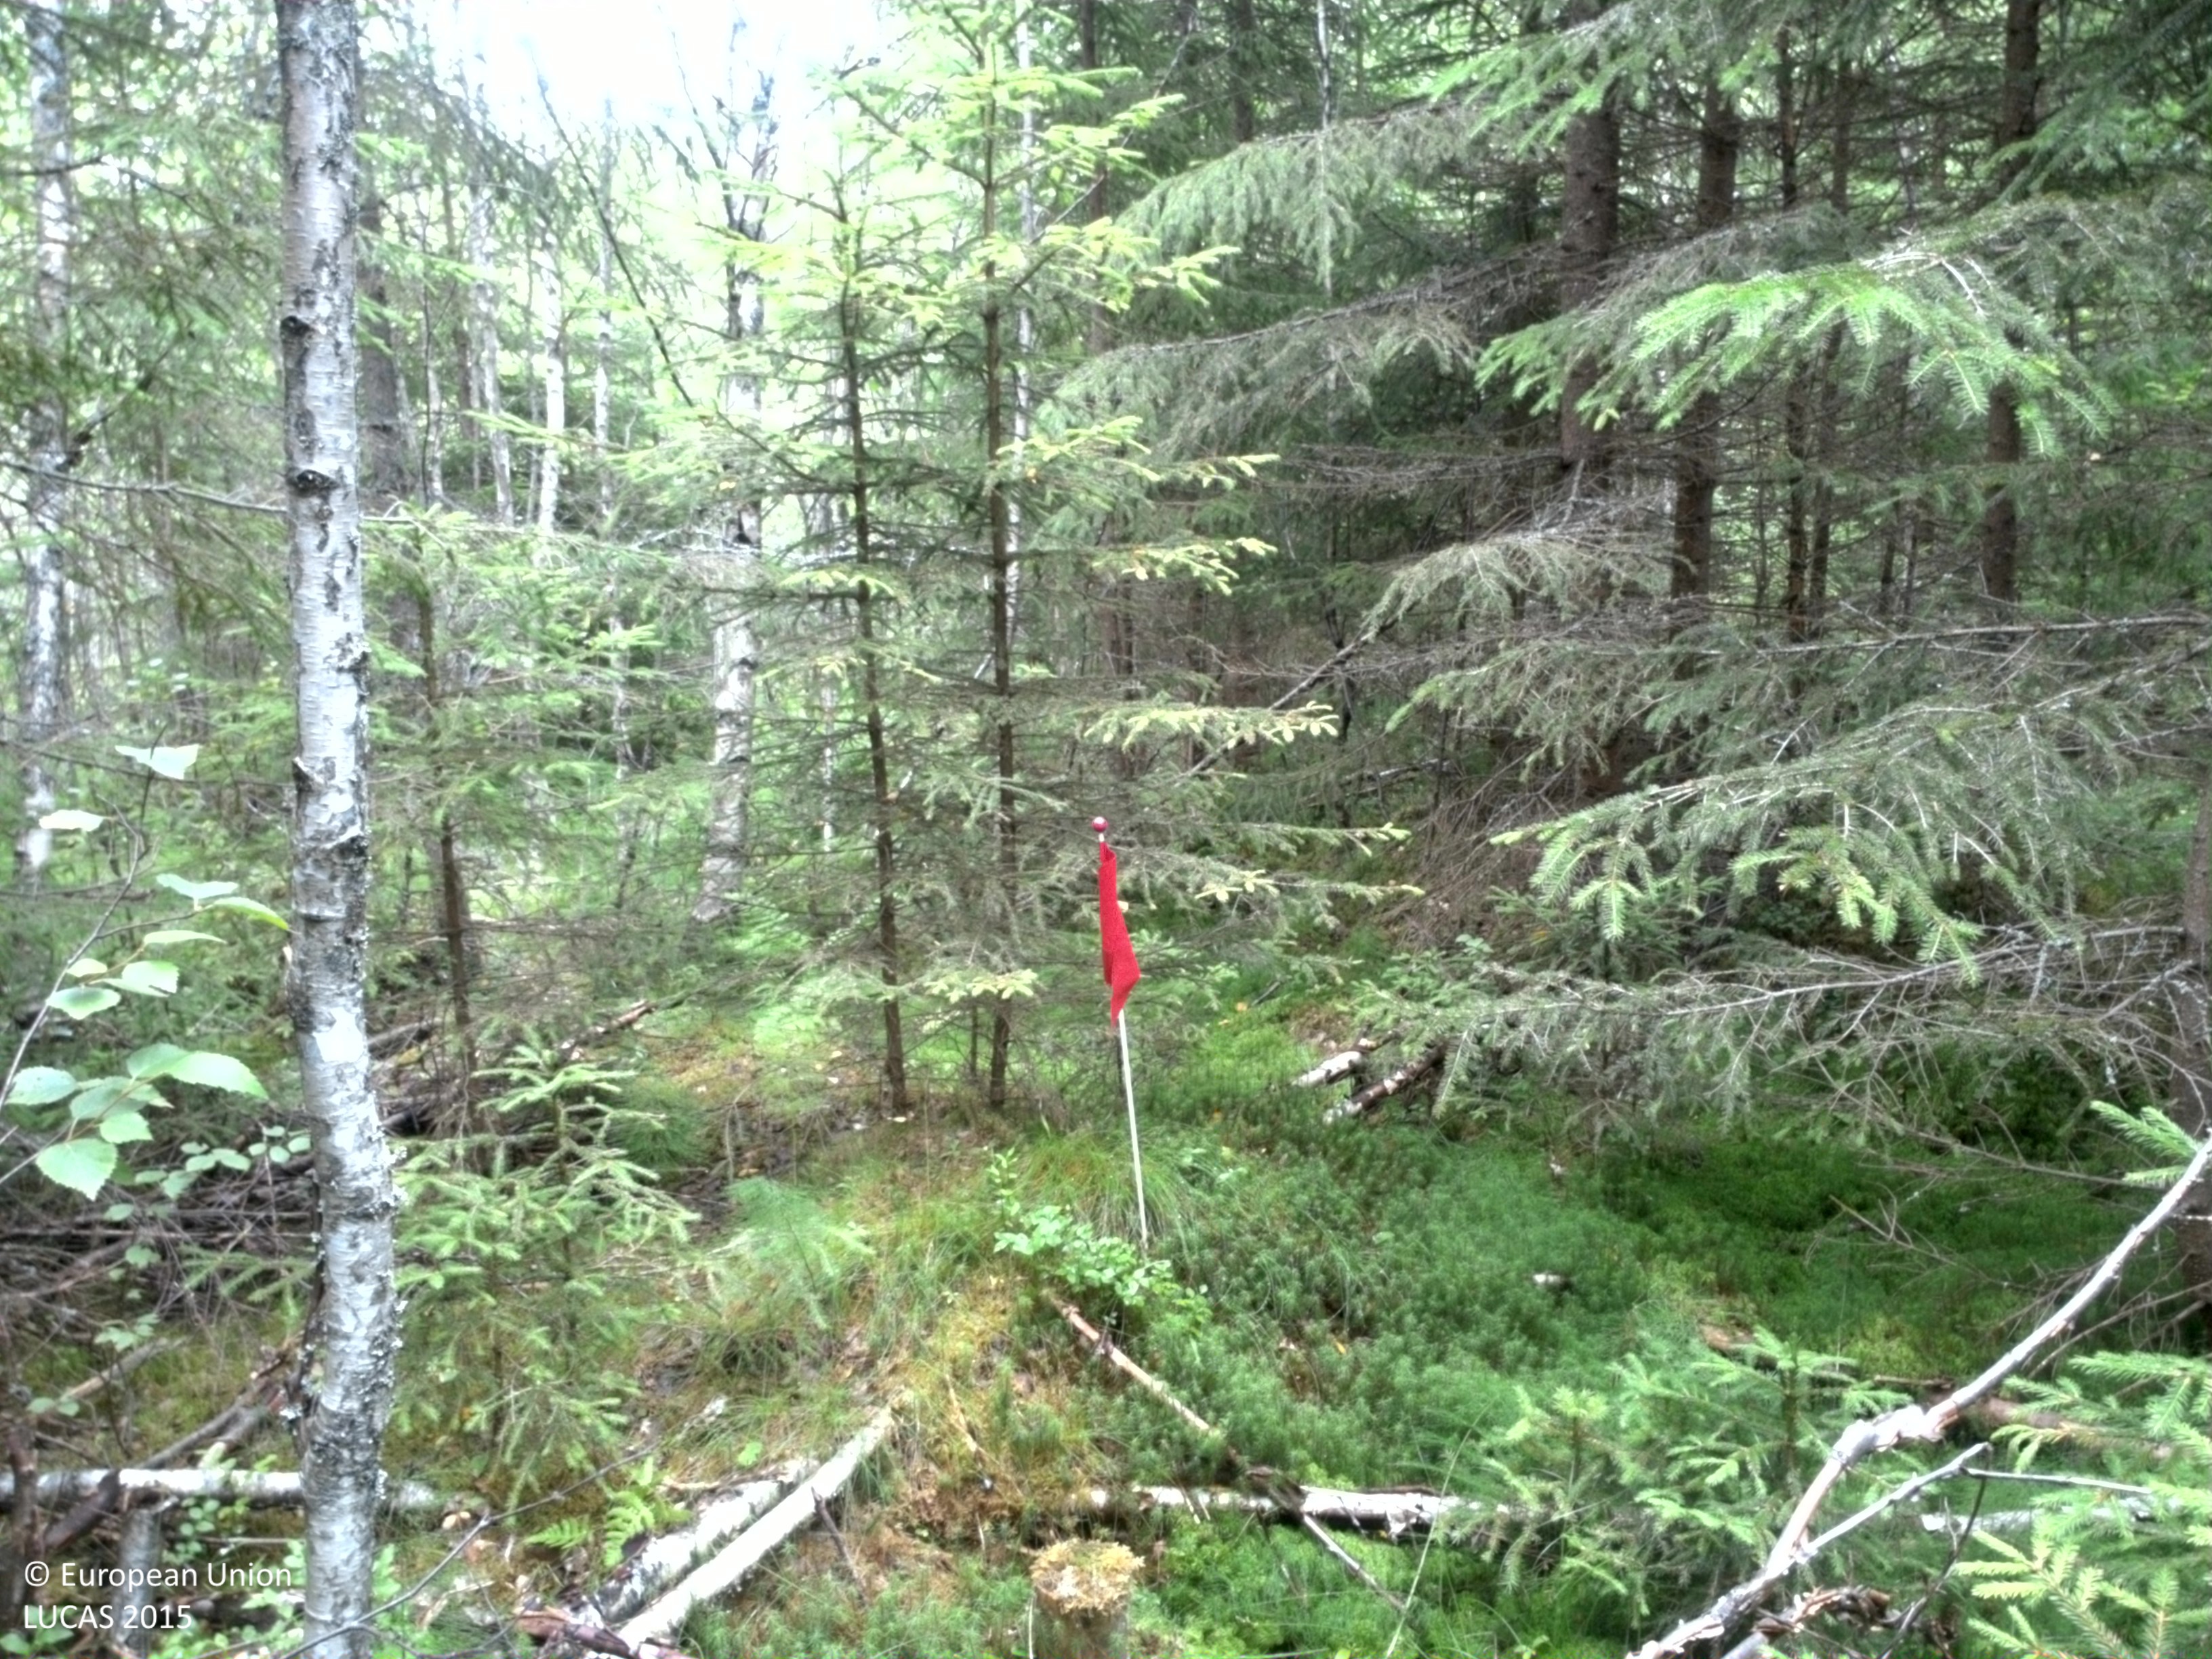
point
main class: Woodland
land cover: Spruce dominated mixed woodland
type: boreal forest
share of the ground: 50 - 75 %
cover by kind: coniferous forest trees 50 %, broadleaved forest trees 20 %, herbaceous plants 15 %, lichens and mosses 15 %
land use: Forestry
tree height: > 5 m
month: July
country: SE
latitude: 59.4789
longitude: 13.1524
